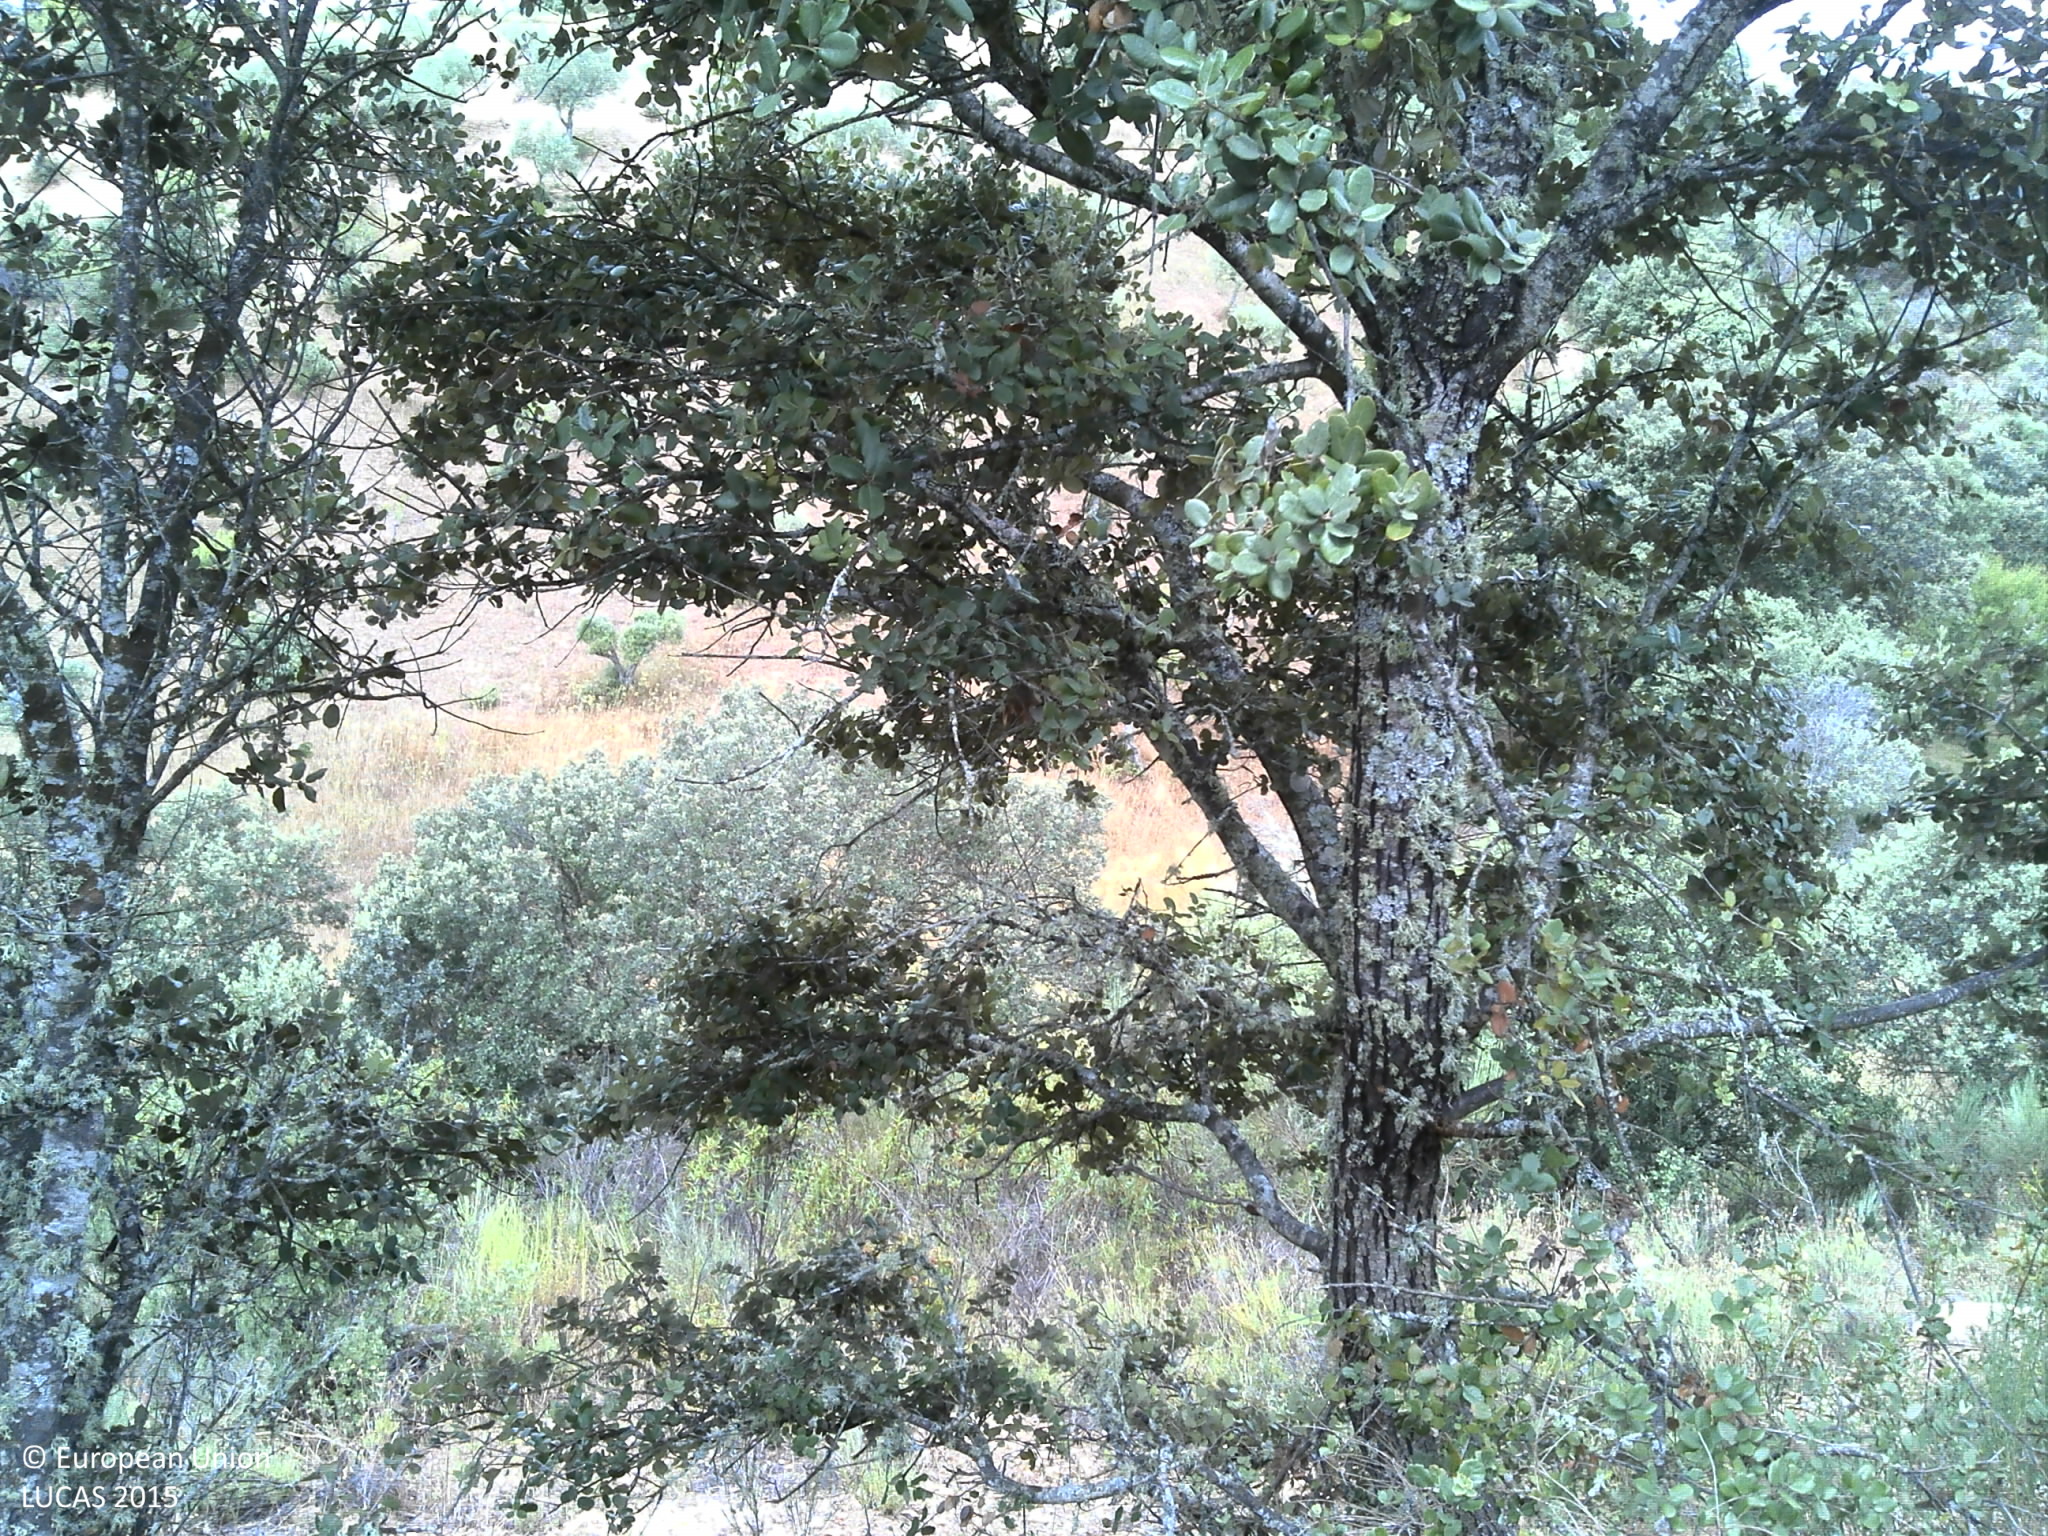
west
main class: Woodland
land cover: Broadleaved woodland
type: broadleaved evergreen forest
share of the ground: 10 - 25 %
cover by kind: shrubs 70 %, unconsolidated bare surface 20 %, broadleaved forest trees 10 %
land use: Semi-natural and natural areas not in use
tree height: > 5 m
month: June
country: PT
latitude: 41.3854
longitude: -6.9123
